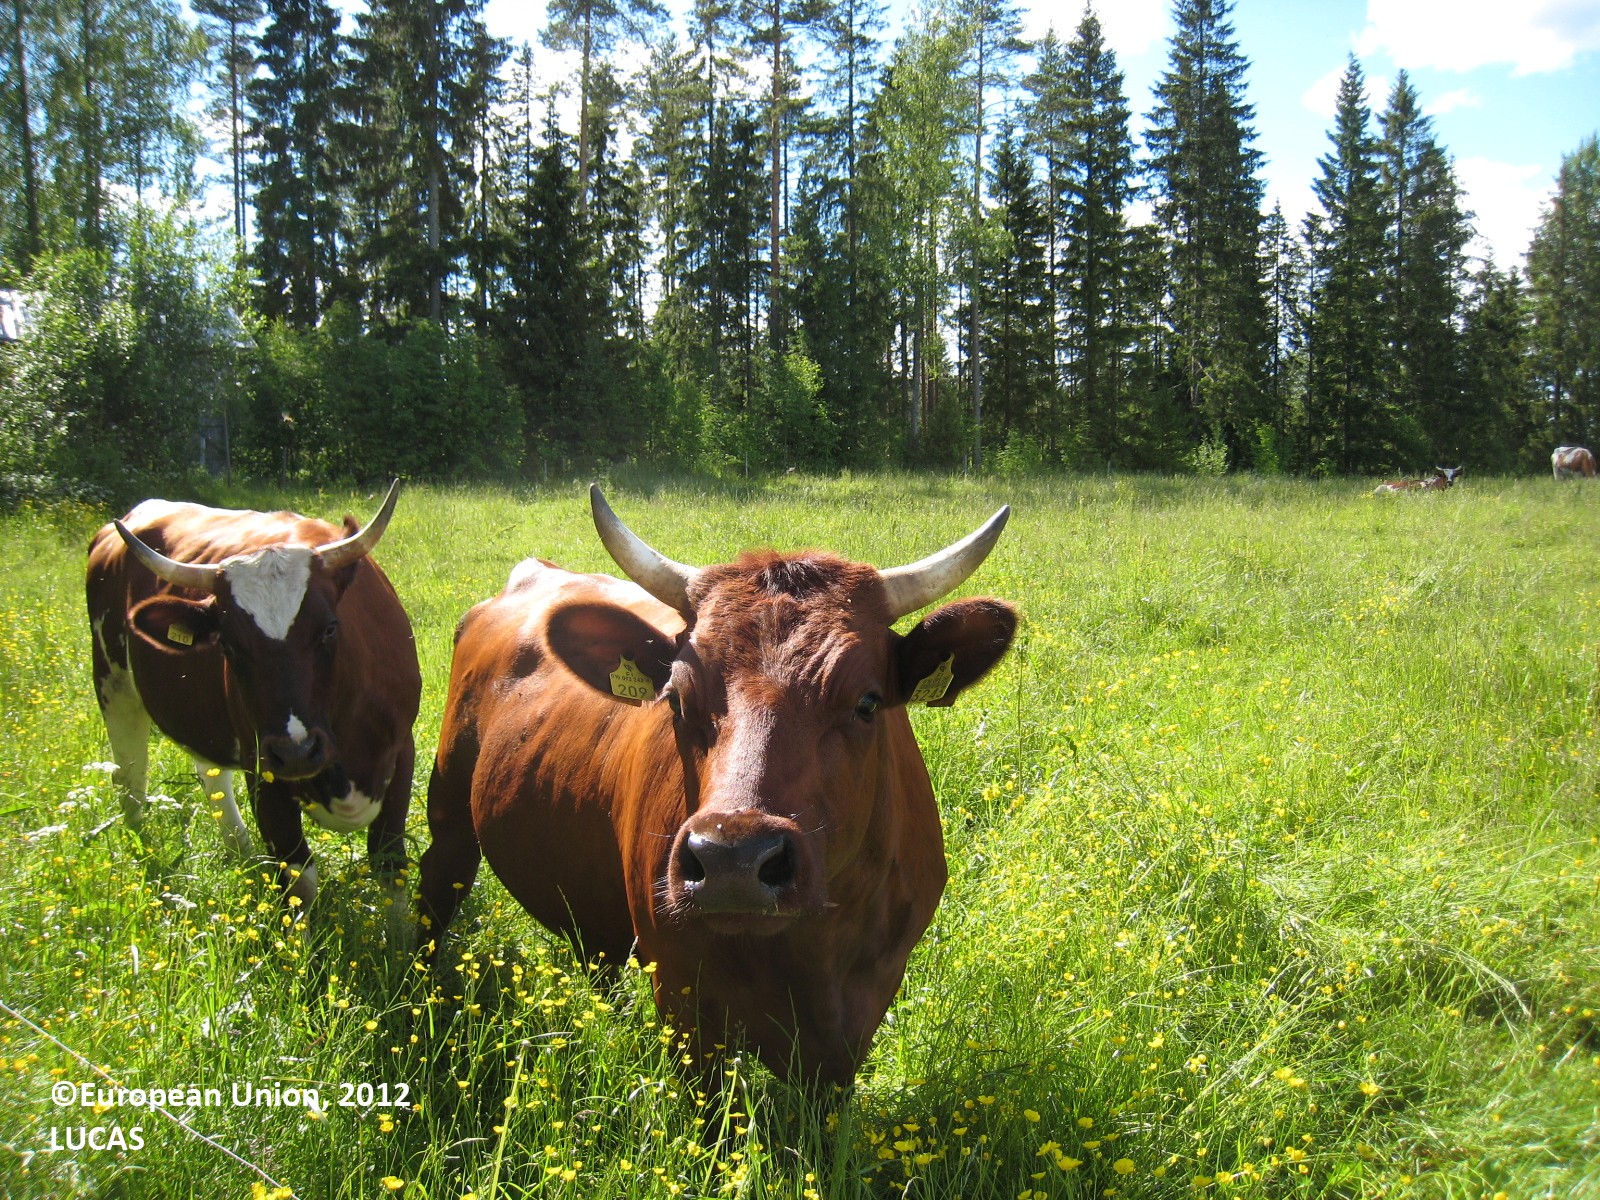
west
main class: Grassland
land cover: Grassland without tree/shrub cover
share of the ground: > 75 %
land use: Agriculture (excluding fallow land and kitchen gardens)
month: June
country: FI
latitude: 62.4832
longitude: 26.3734
